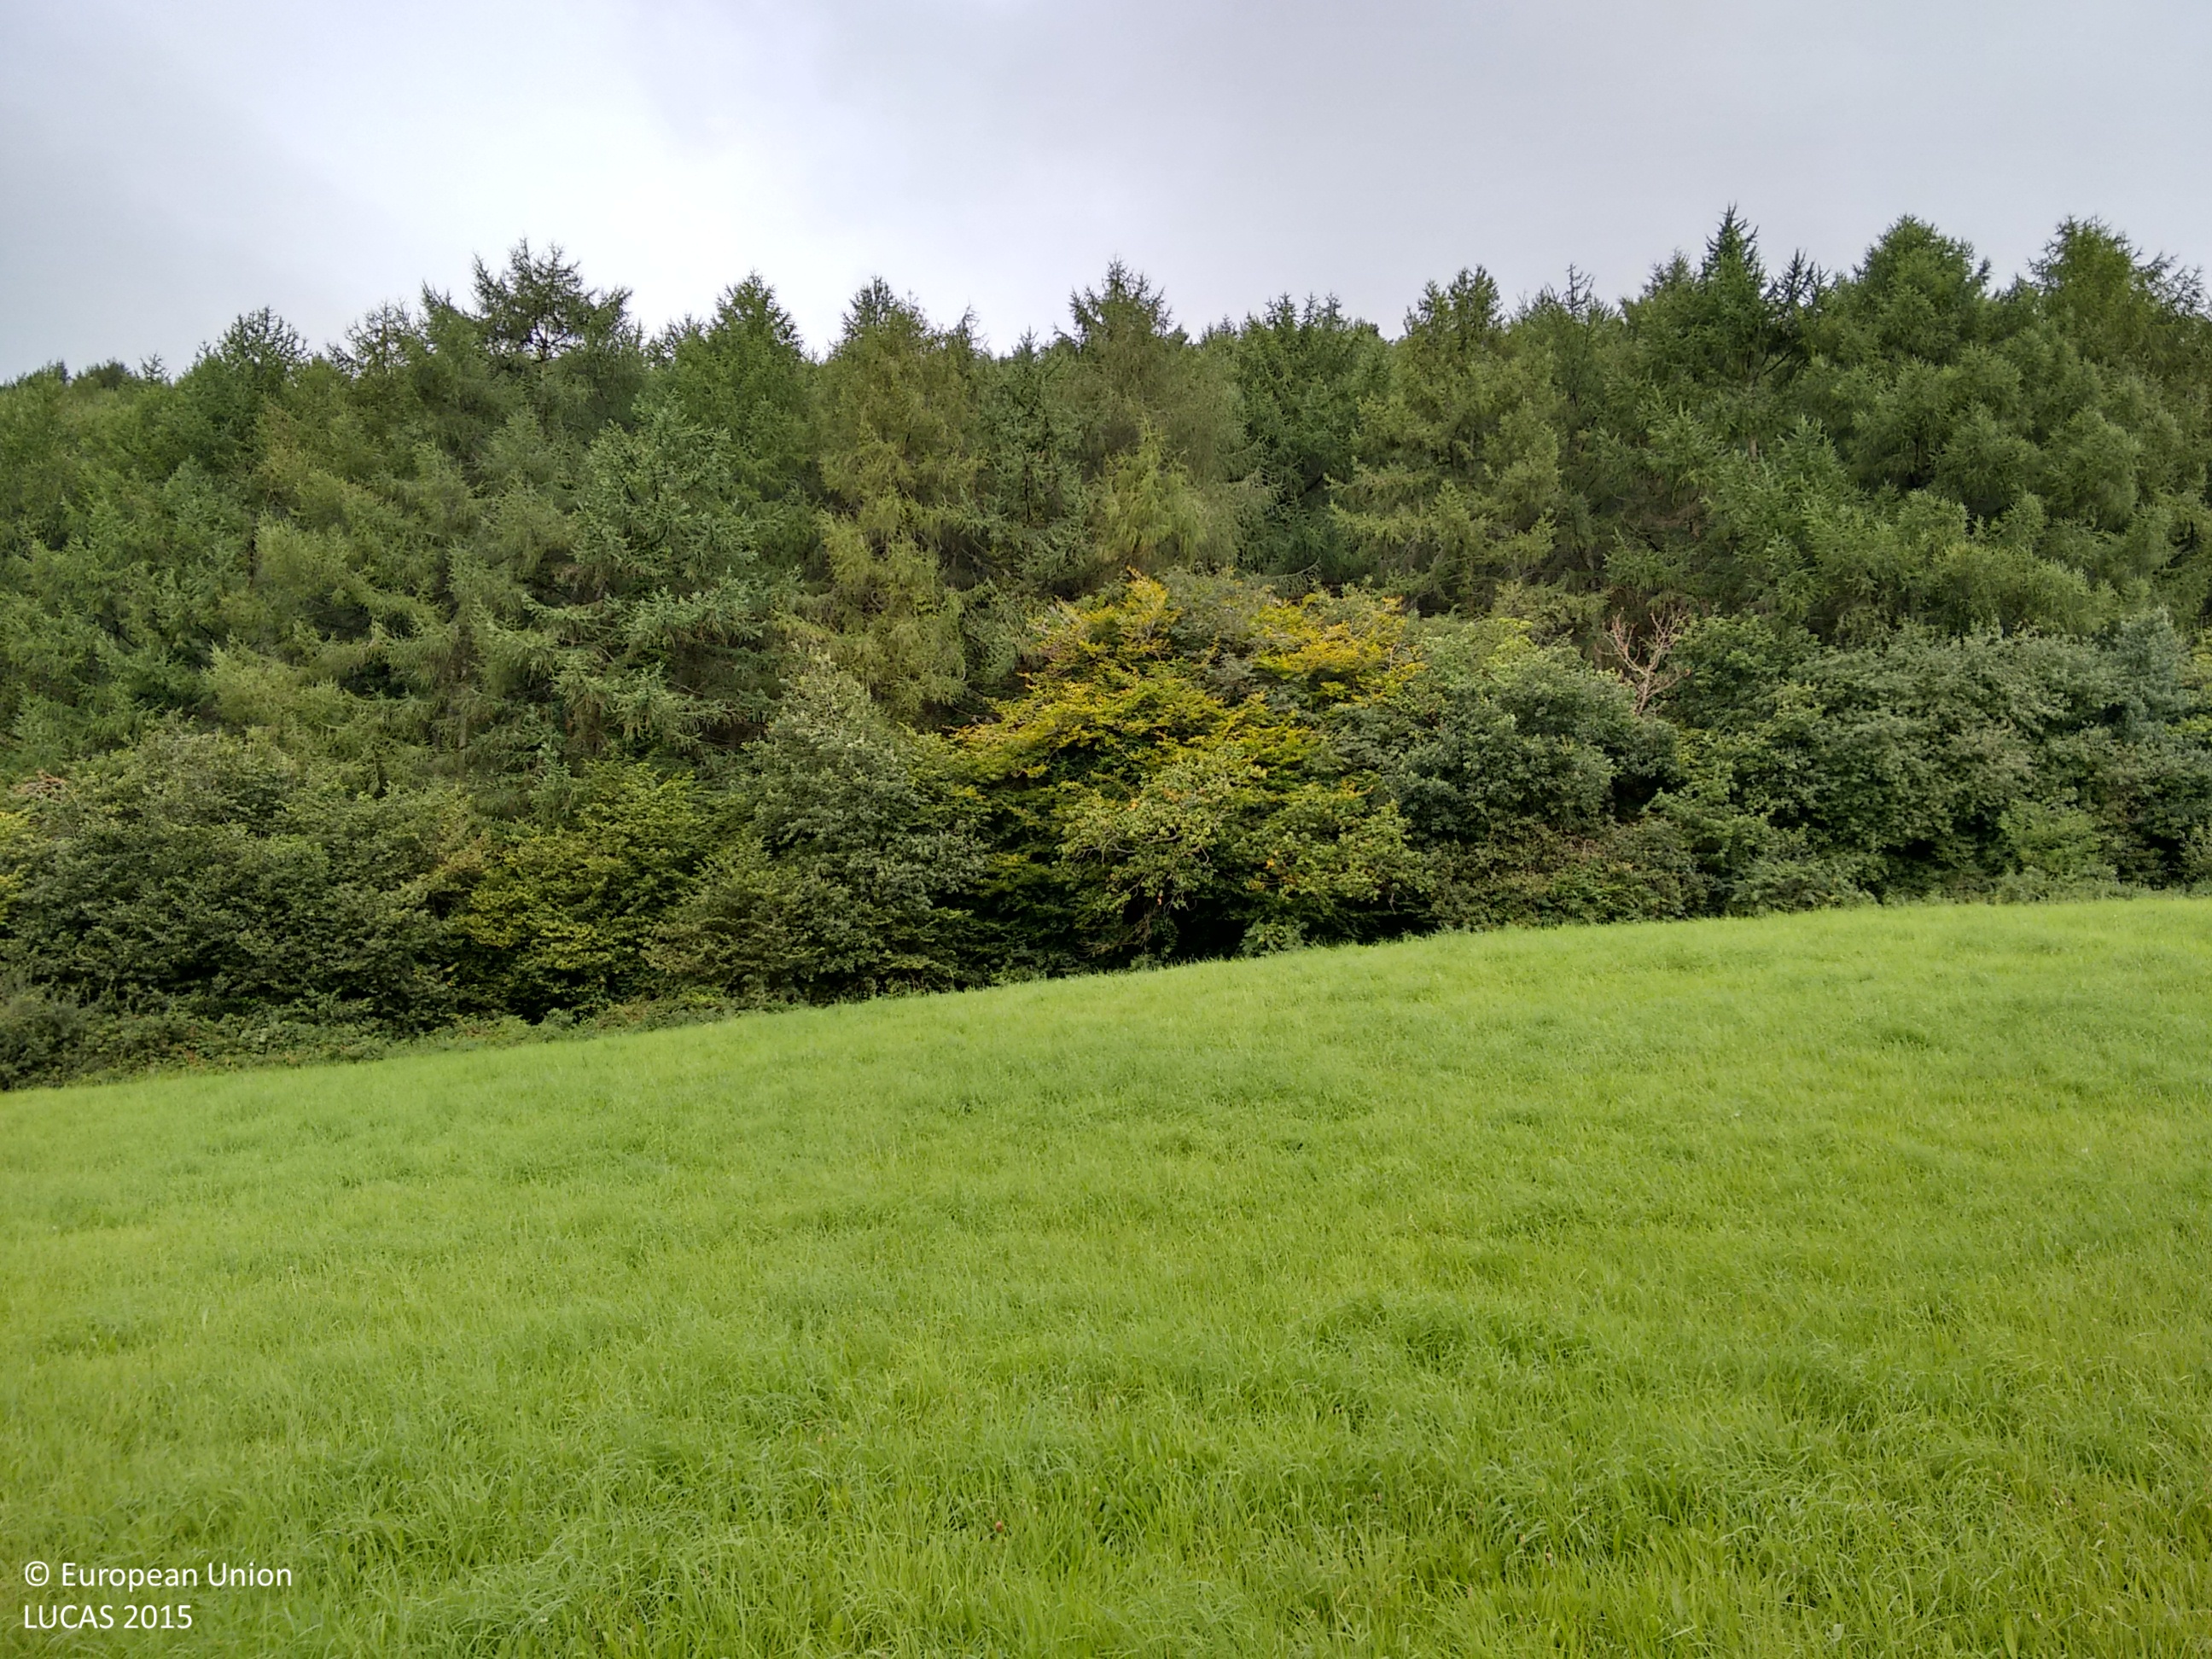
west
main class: Grassland
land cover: Grassland without tree/shrub cover
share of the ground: > 75 %
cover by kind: herbaceous plants 100 %
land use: Agriculture (excluding fallow land and kitchen gardens)
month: September
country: GB
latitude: 51.5544
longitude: -3.2770
